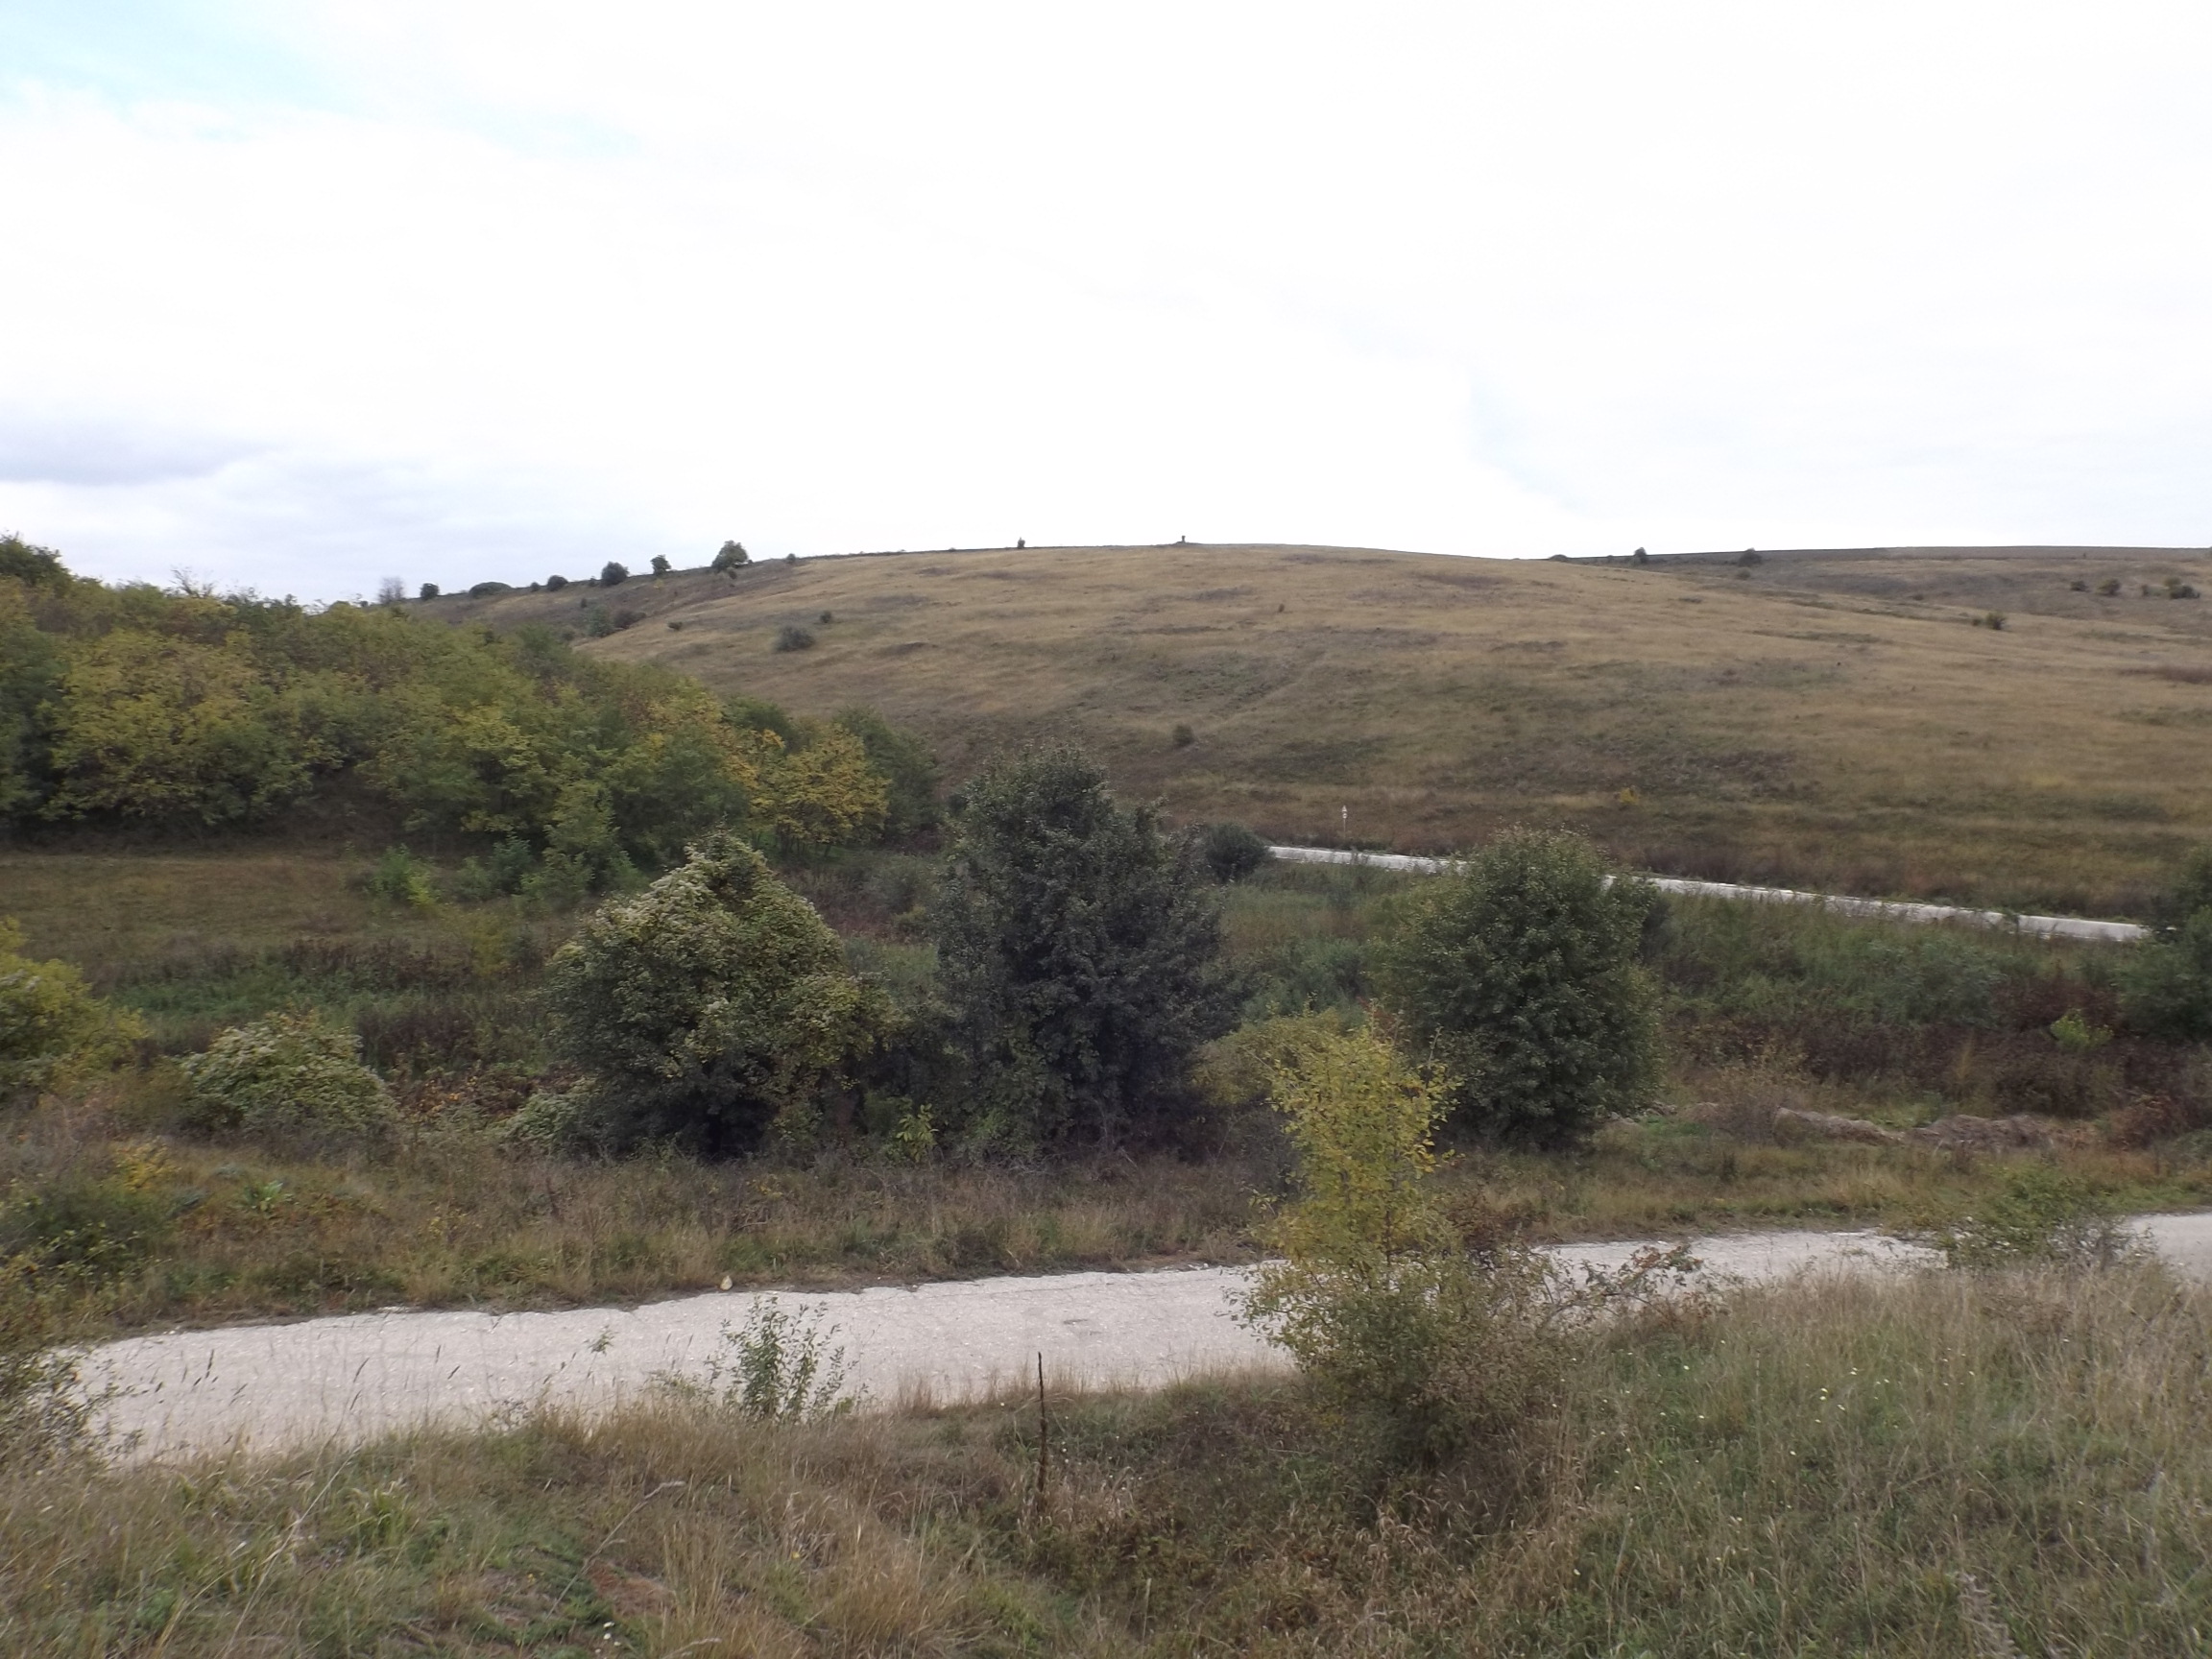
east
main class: Grassland
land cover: Grassland without tree/shrub cover
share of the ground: > 75 %
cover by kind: herbaceous plants 100 %
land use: Agriculture (excluding fallow land and kitchen gardens)
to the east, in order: Grassland without tree/shrub cover; Paved roads, cycling and walking lanes; Grass margins; Lines of trees; Grassland without tree/shrub cover; Tracks; Spontaneously vegetated surfaces; Grassland with sparse tree/shrub cover; Paved roads, cycling and walking lanes; Grassland without tree/shrub cover
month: October
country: BG
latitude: 44.0529
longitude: 26.8072
